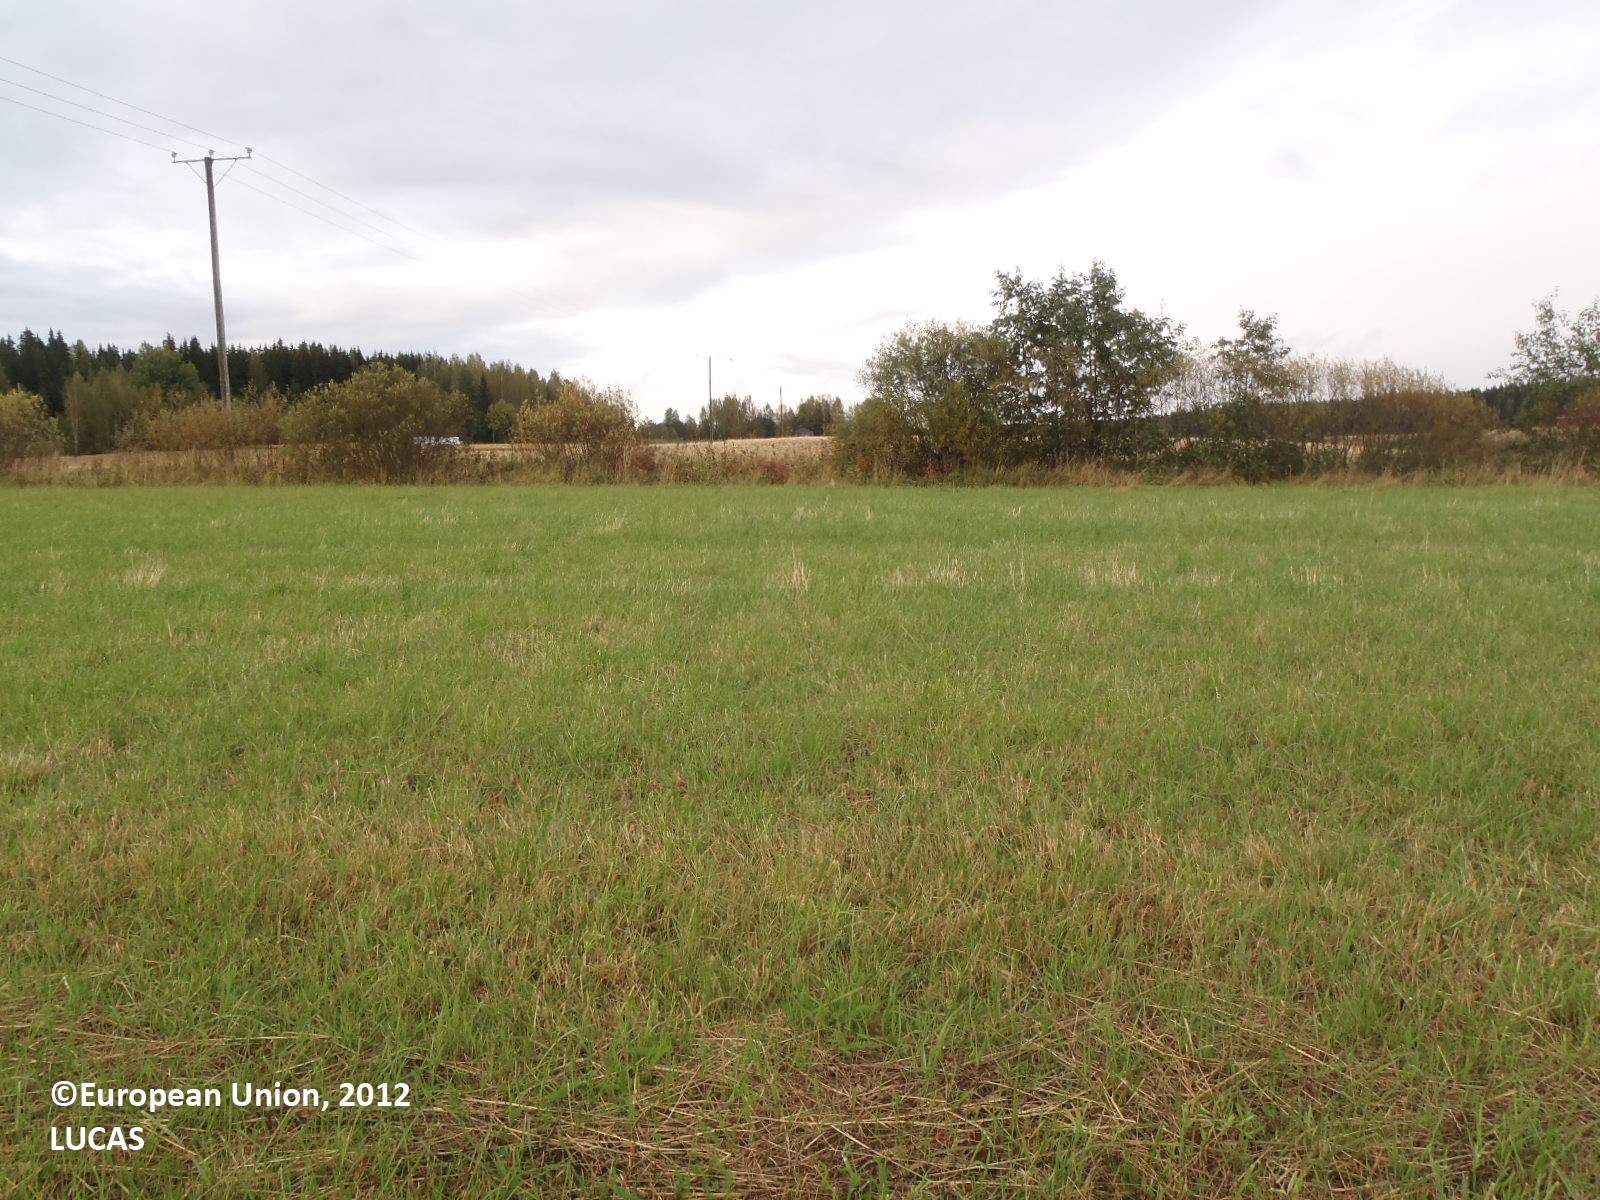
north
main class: Cropland
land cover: Temporary grasslands
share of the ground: > 75 %
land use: Agriculture (excluding fallow land and kitchen gardens)
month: September
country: FI
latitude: 61.6820
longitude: 22.5539
